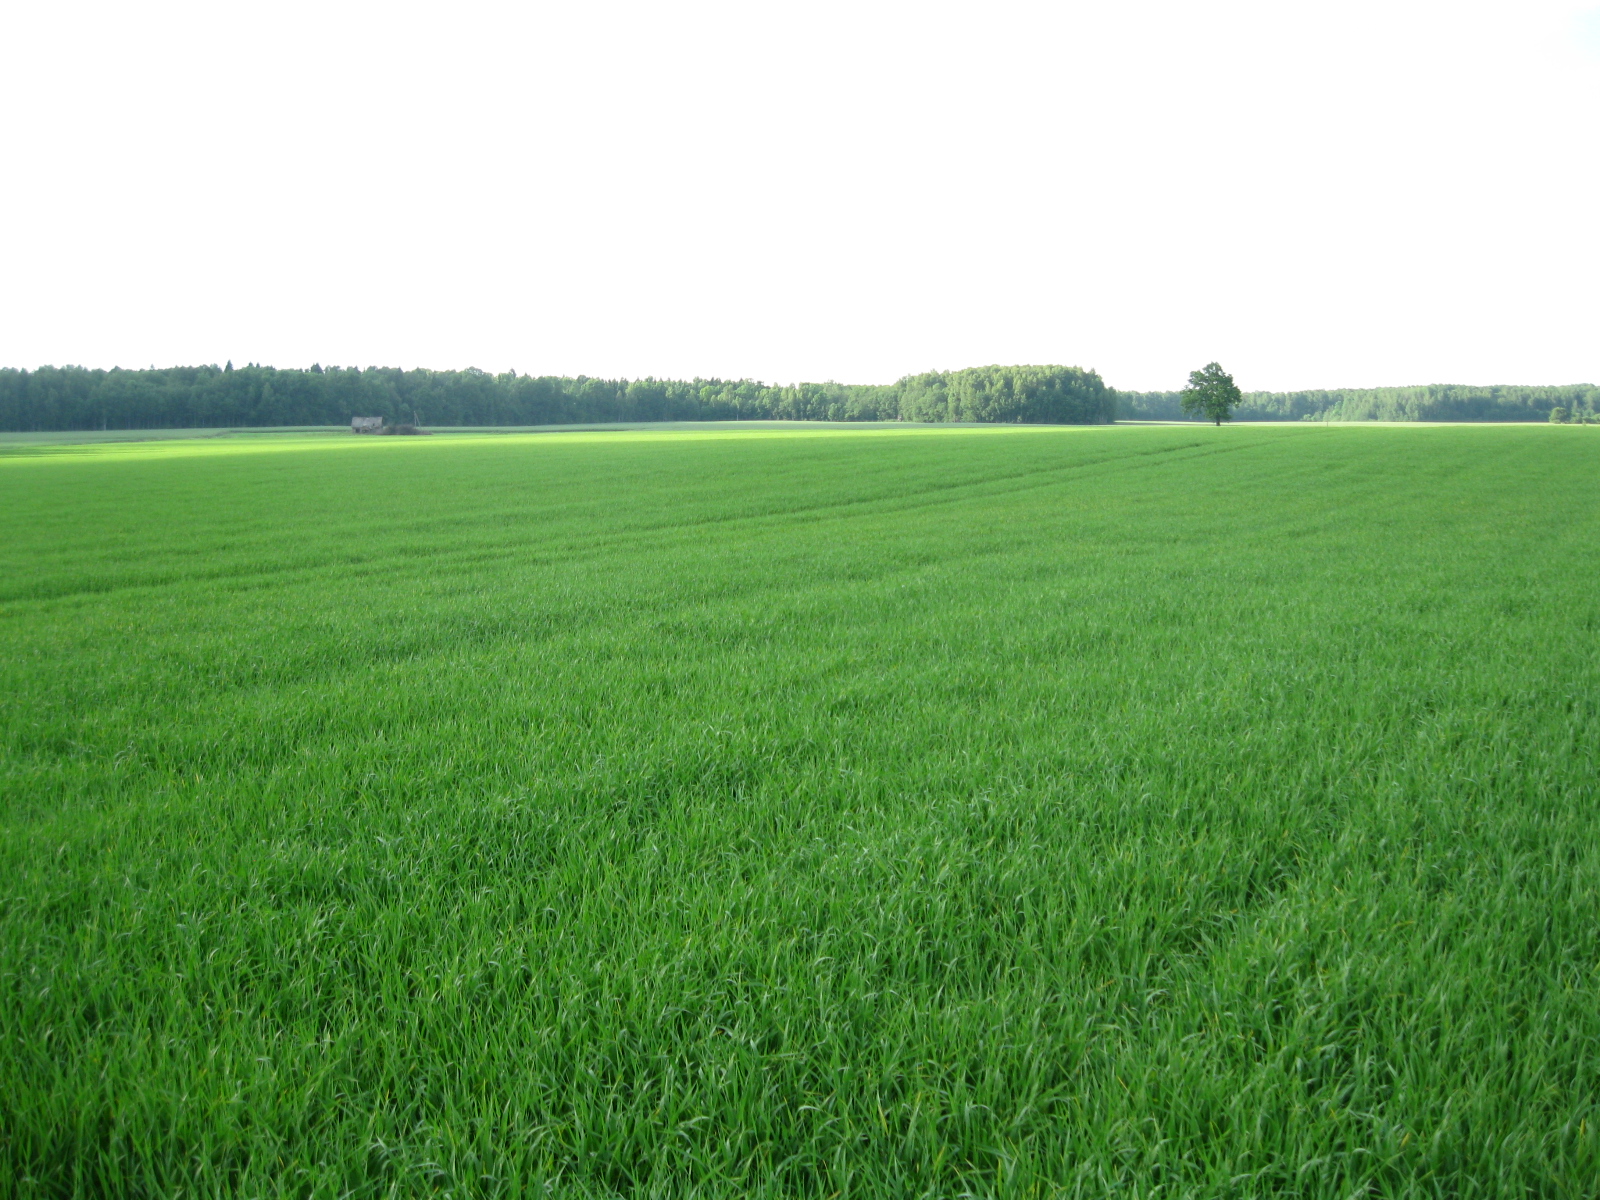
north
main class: Cropland
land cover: Barley
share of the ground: > 75 %
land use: Agriculture (excluding fallow land and kitchen gardens)
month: June
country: LT
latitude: 55.5753
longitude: 23.7075
